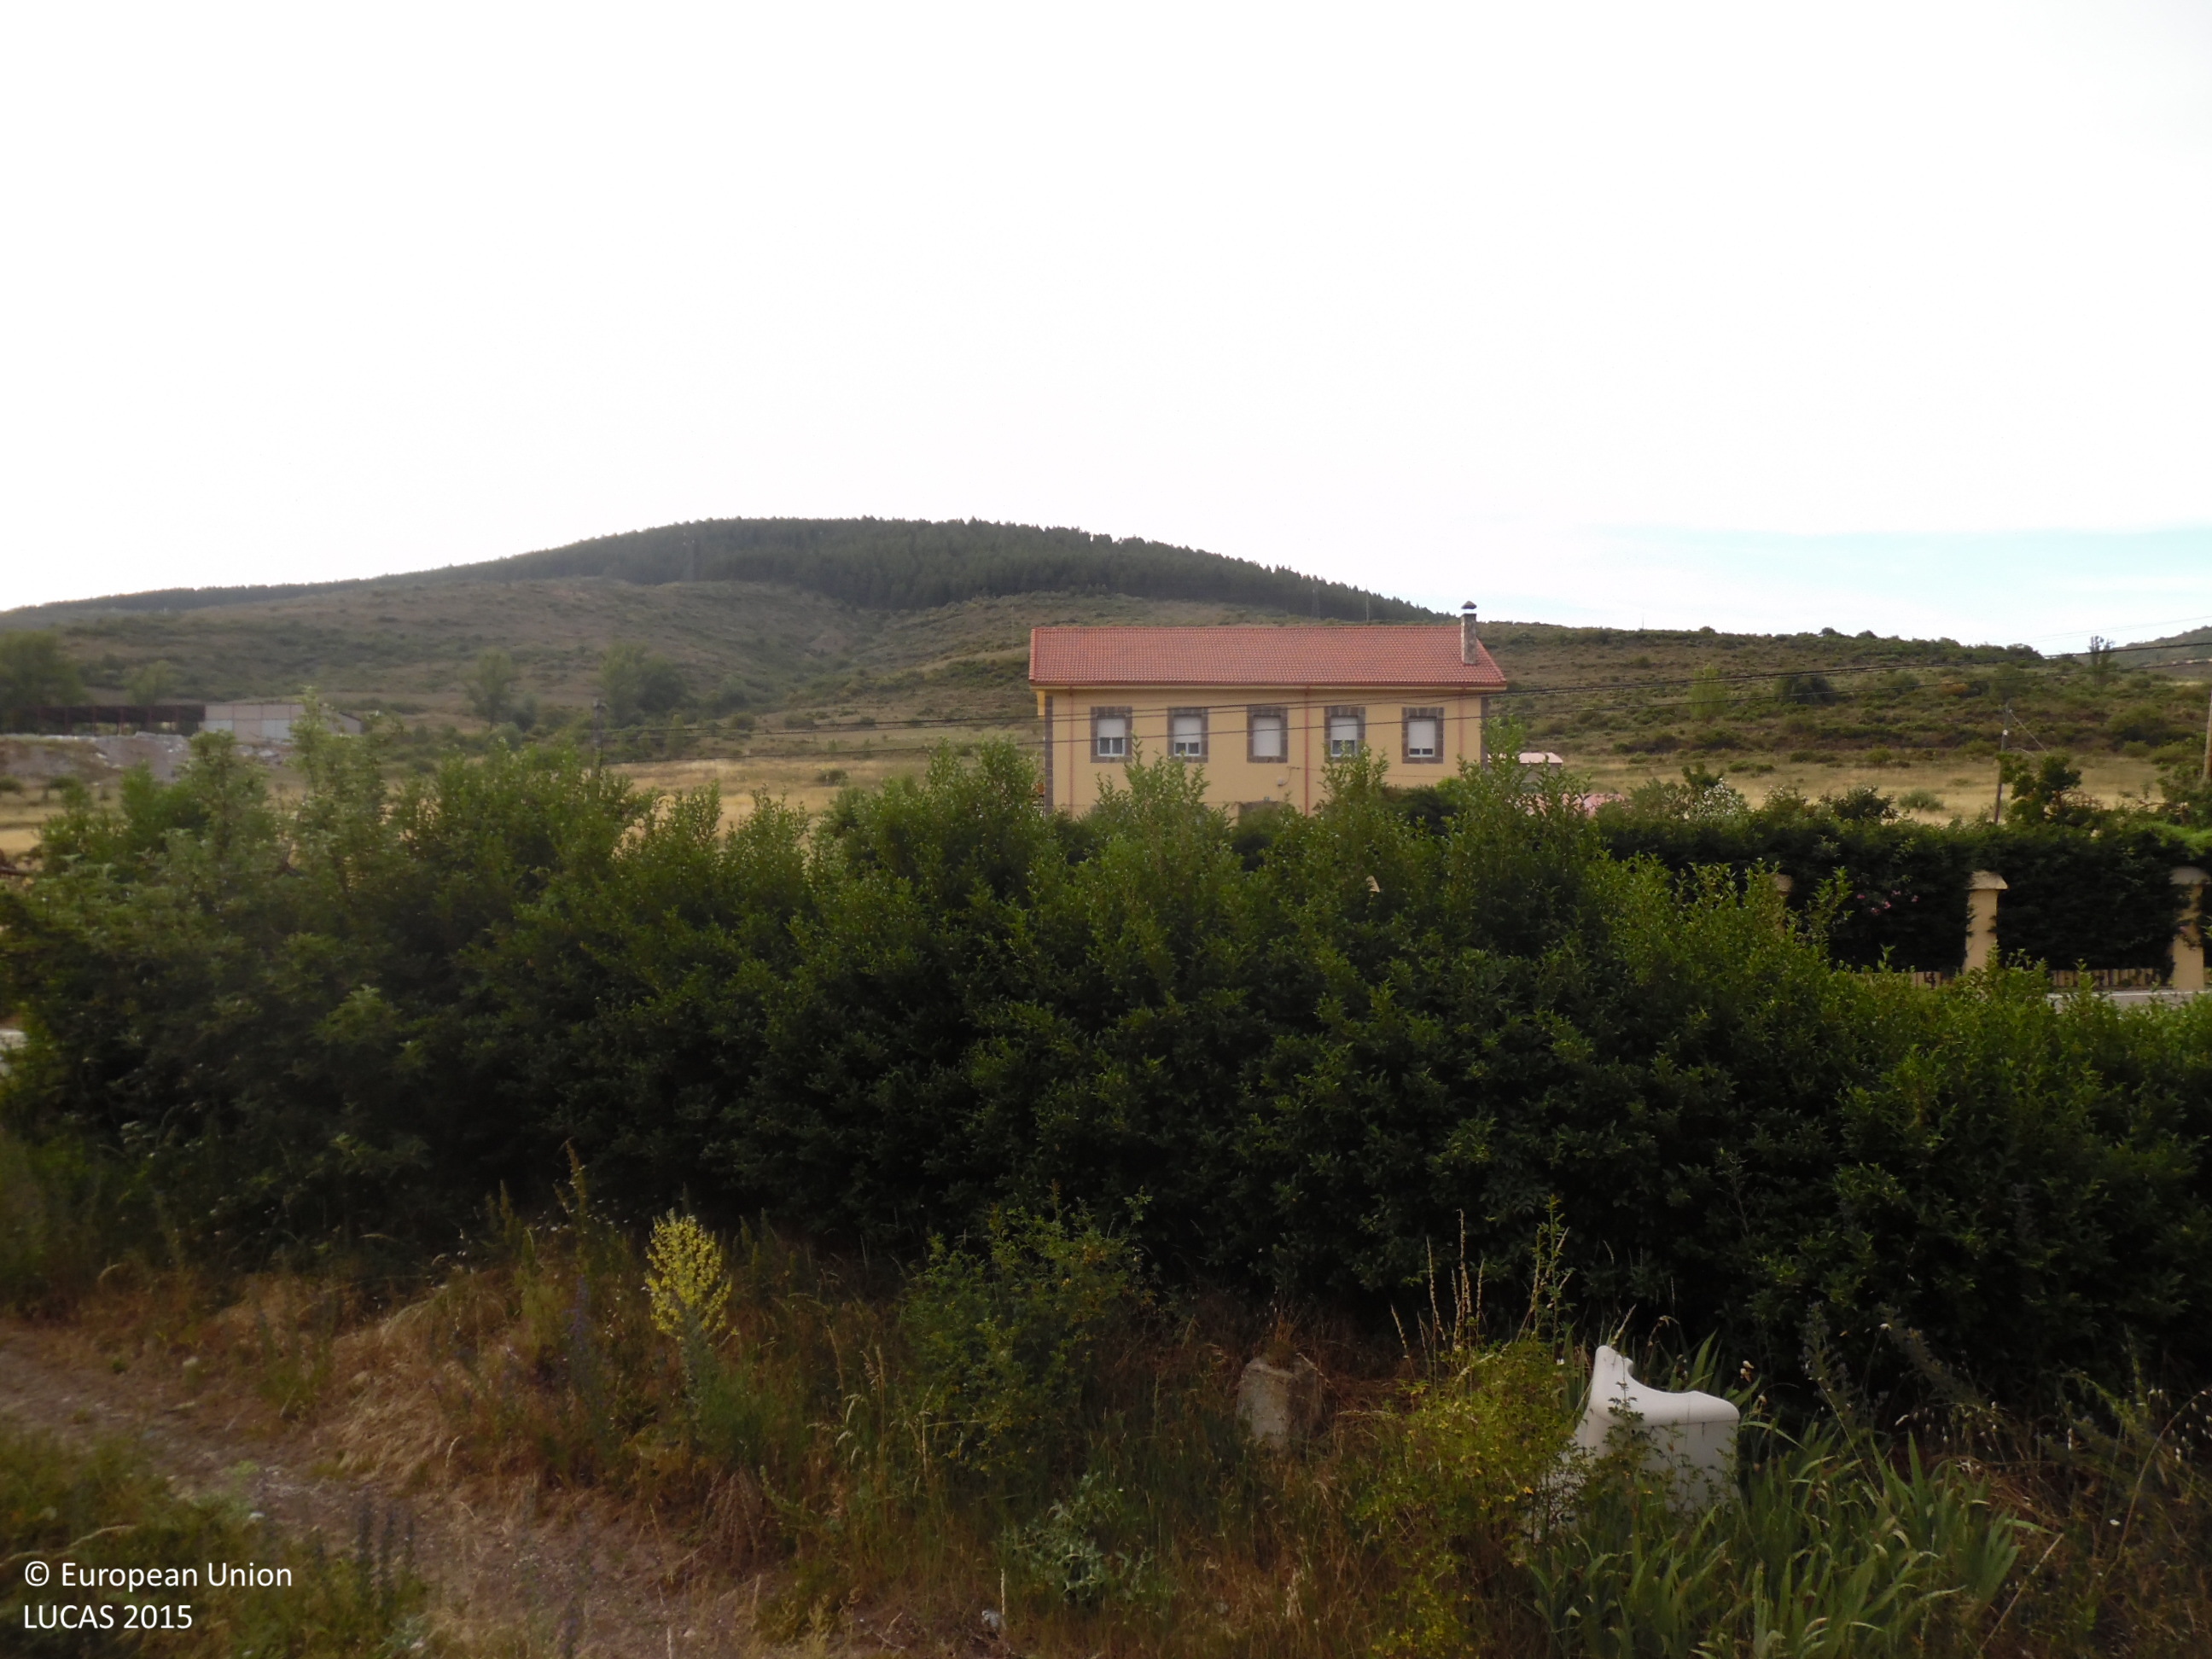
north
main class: Grassland
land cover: Grassland with sparse tree/shrub cover
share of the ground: 10 - 25 %
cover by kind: unconsolidated bare surface 70 %, herbaceous plants 25 %, broadleaved forest trees 5 %
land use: Road transport
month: June
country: ES
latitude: 42.7841
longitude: -5.7875
